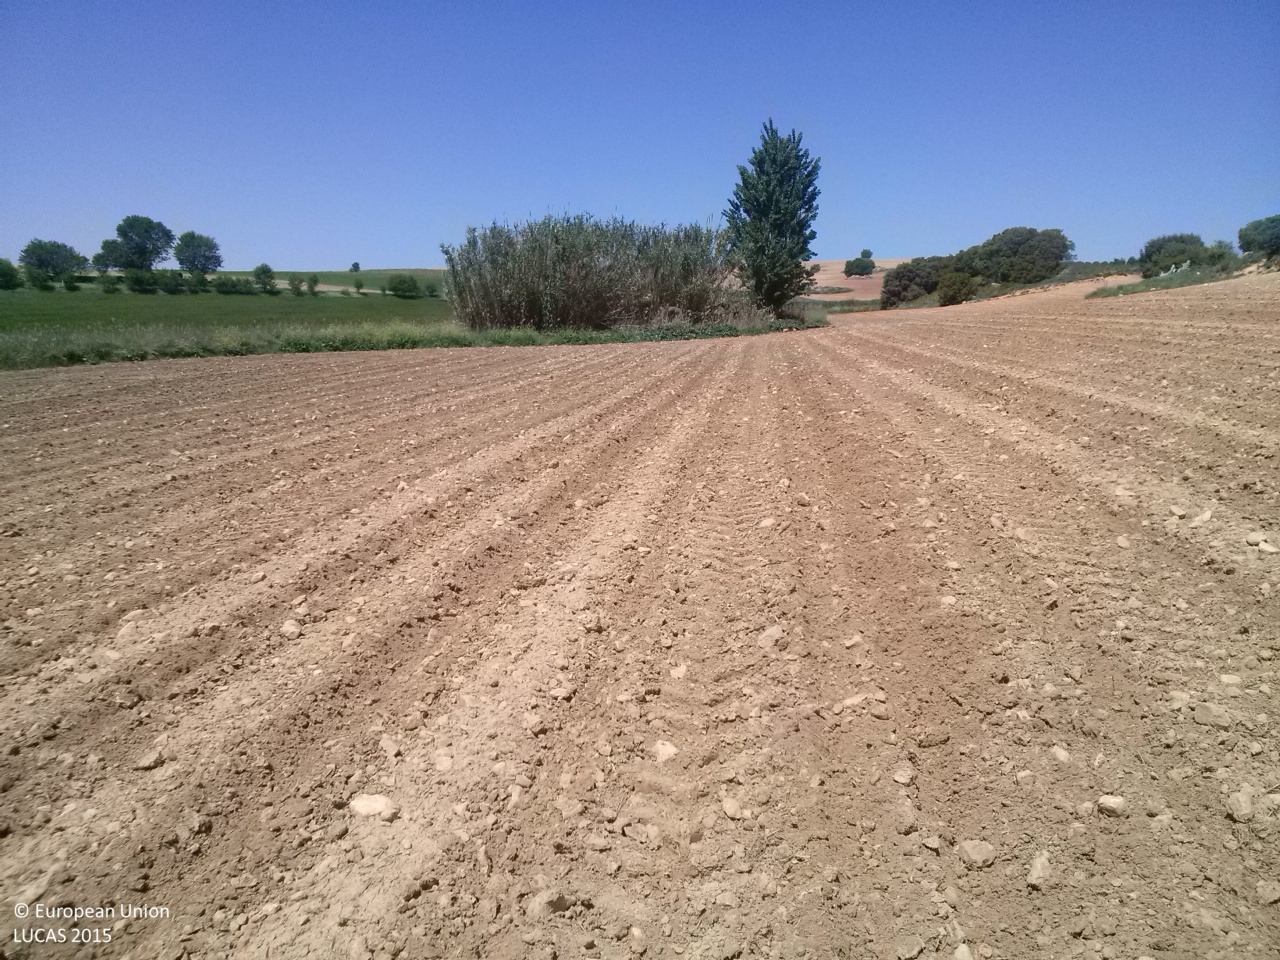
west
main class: Cropland
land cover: Sunflower
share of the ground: < 10 %
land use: Agriculture (excluding fallow land and kitchen gardens)
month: May
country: ES
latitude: 39.7429
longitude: -2.7492
